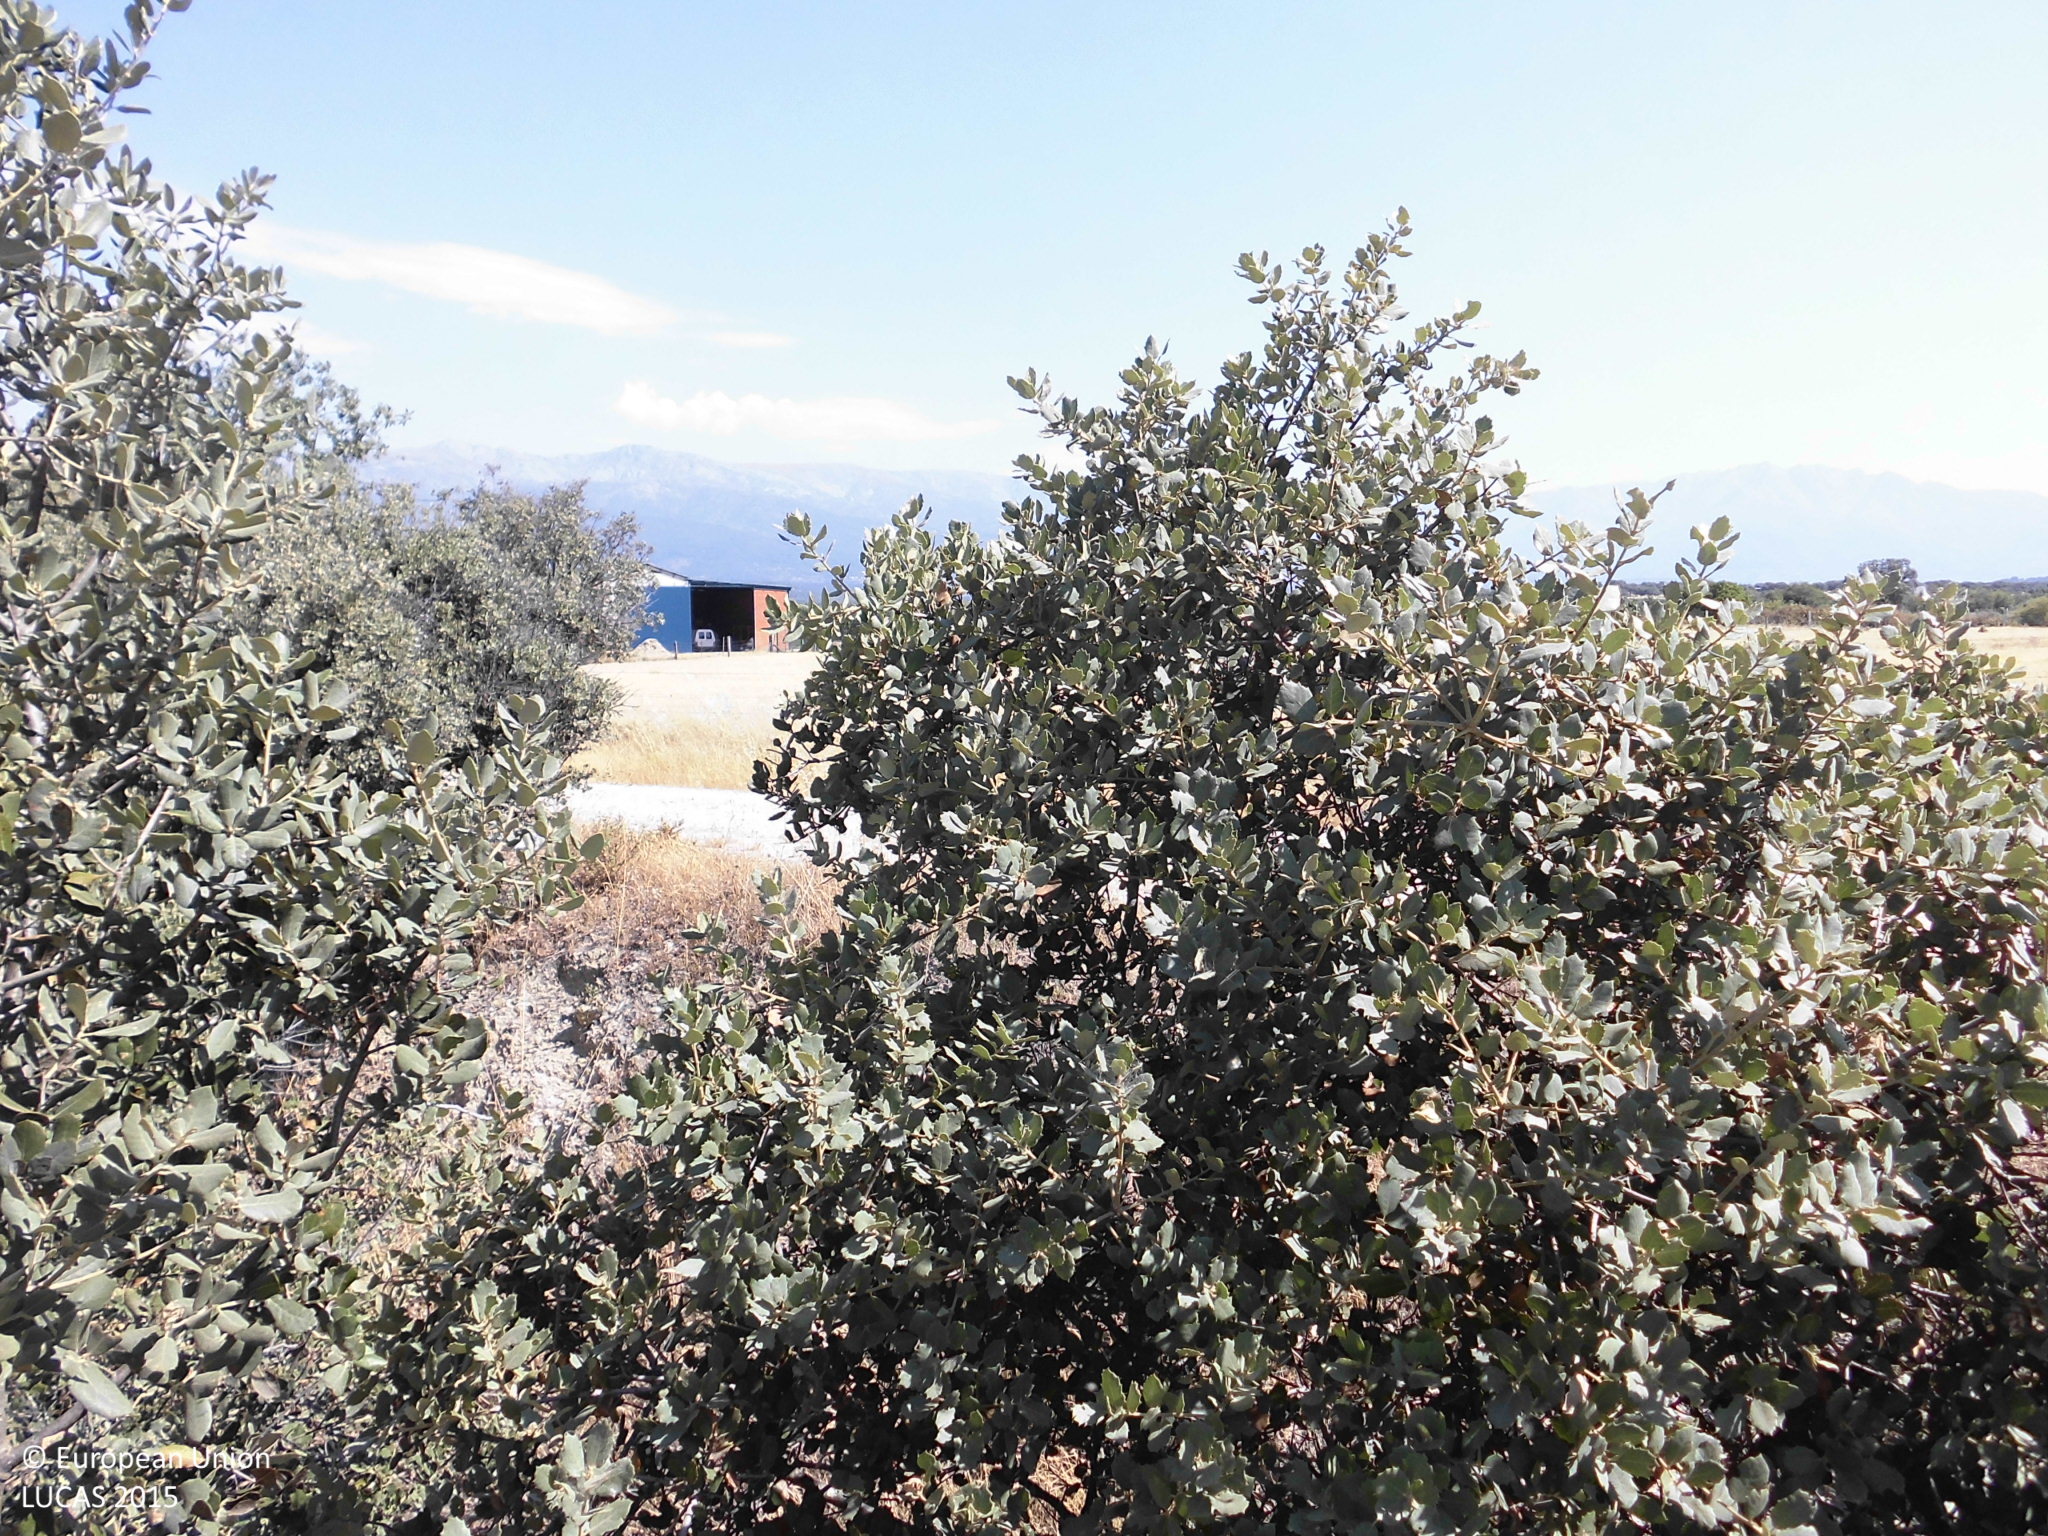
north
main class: Grassland
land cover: Grassland with sparse tree/shrub cover
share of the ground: 25 - 50 %
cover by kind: herbaceous plants 60 %, consolidated bare surface 30 %, broadleaved forest trees 5 %, shrubs 5 %
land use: Abandoned areas
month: June
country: ES
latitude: 40.0249
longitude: -5.4681
